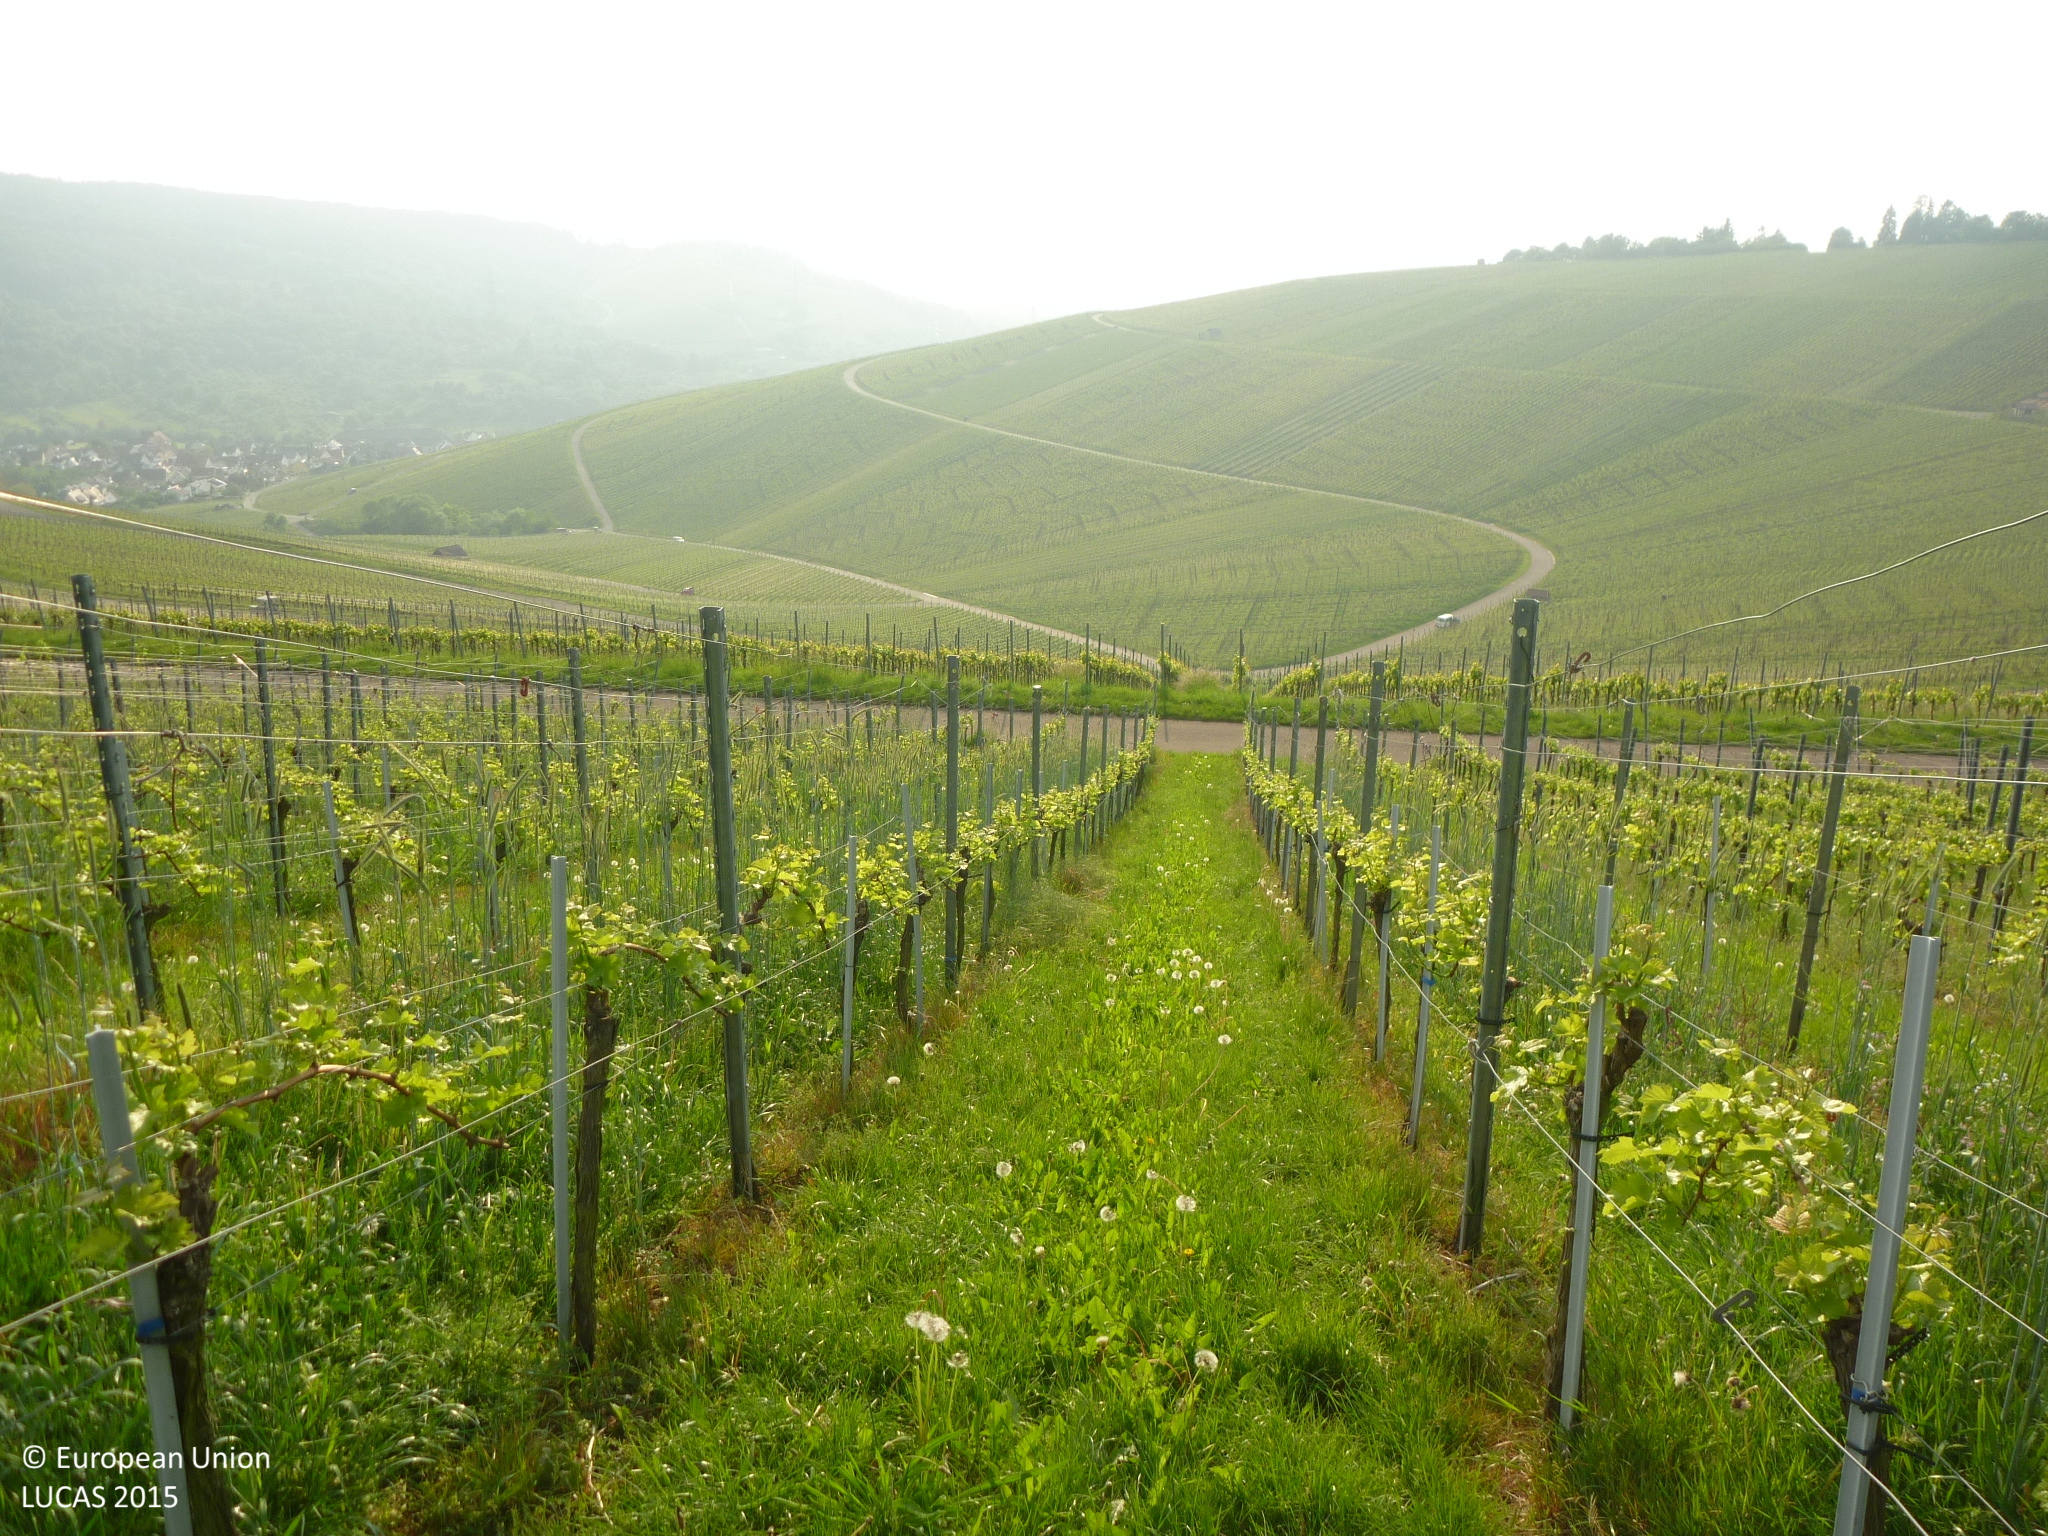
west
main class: Cropland
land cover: Vineyards
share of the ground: 10 - 25 %
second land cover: Grassland without tree/shrub cover
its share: > 75 %
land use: Agriculture (excluding fallow land and kitchen gardens)
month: May
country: DE
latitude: 48.7978
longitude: 9.4149
